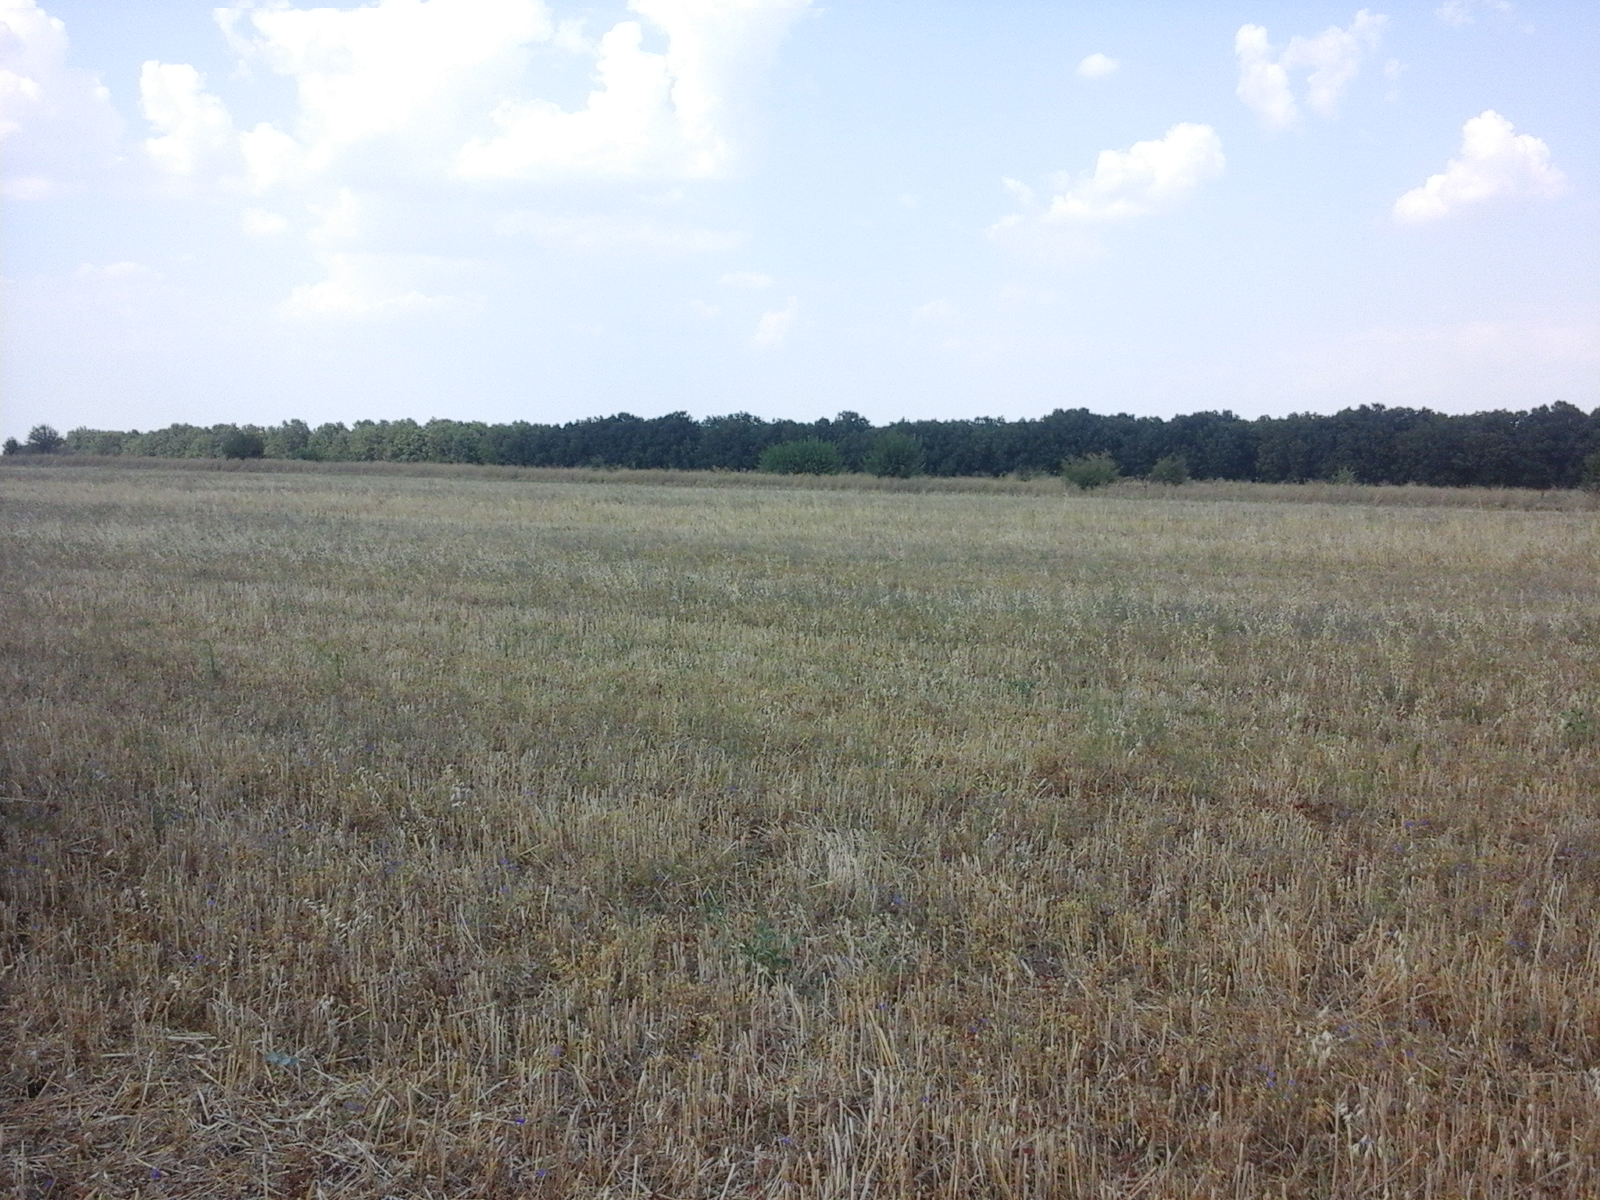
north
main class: Cropland
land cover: Oats
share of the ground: > 75 %
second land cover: Spontaneously vegetated surfaces
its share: 10 - 25 %
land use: Agriculture (excluding fallow land and kitchen gardens)
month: August
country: RO
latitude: 44.1668
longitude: 23.5706
